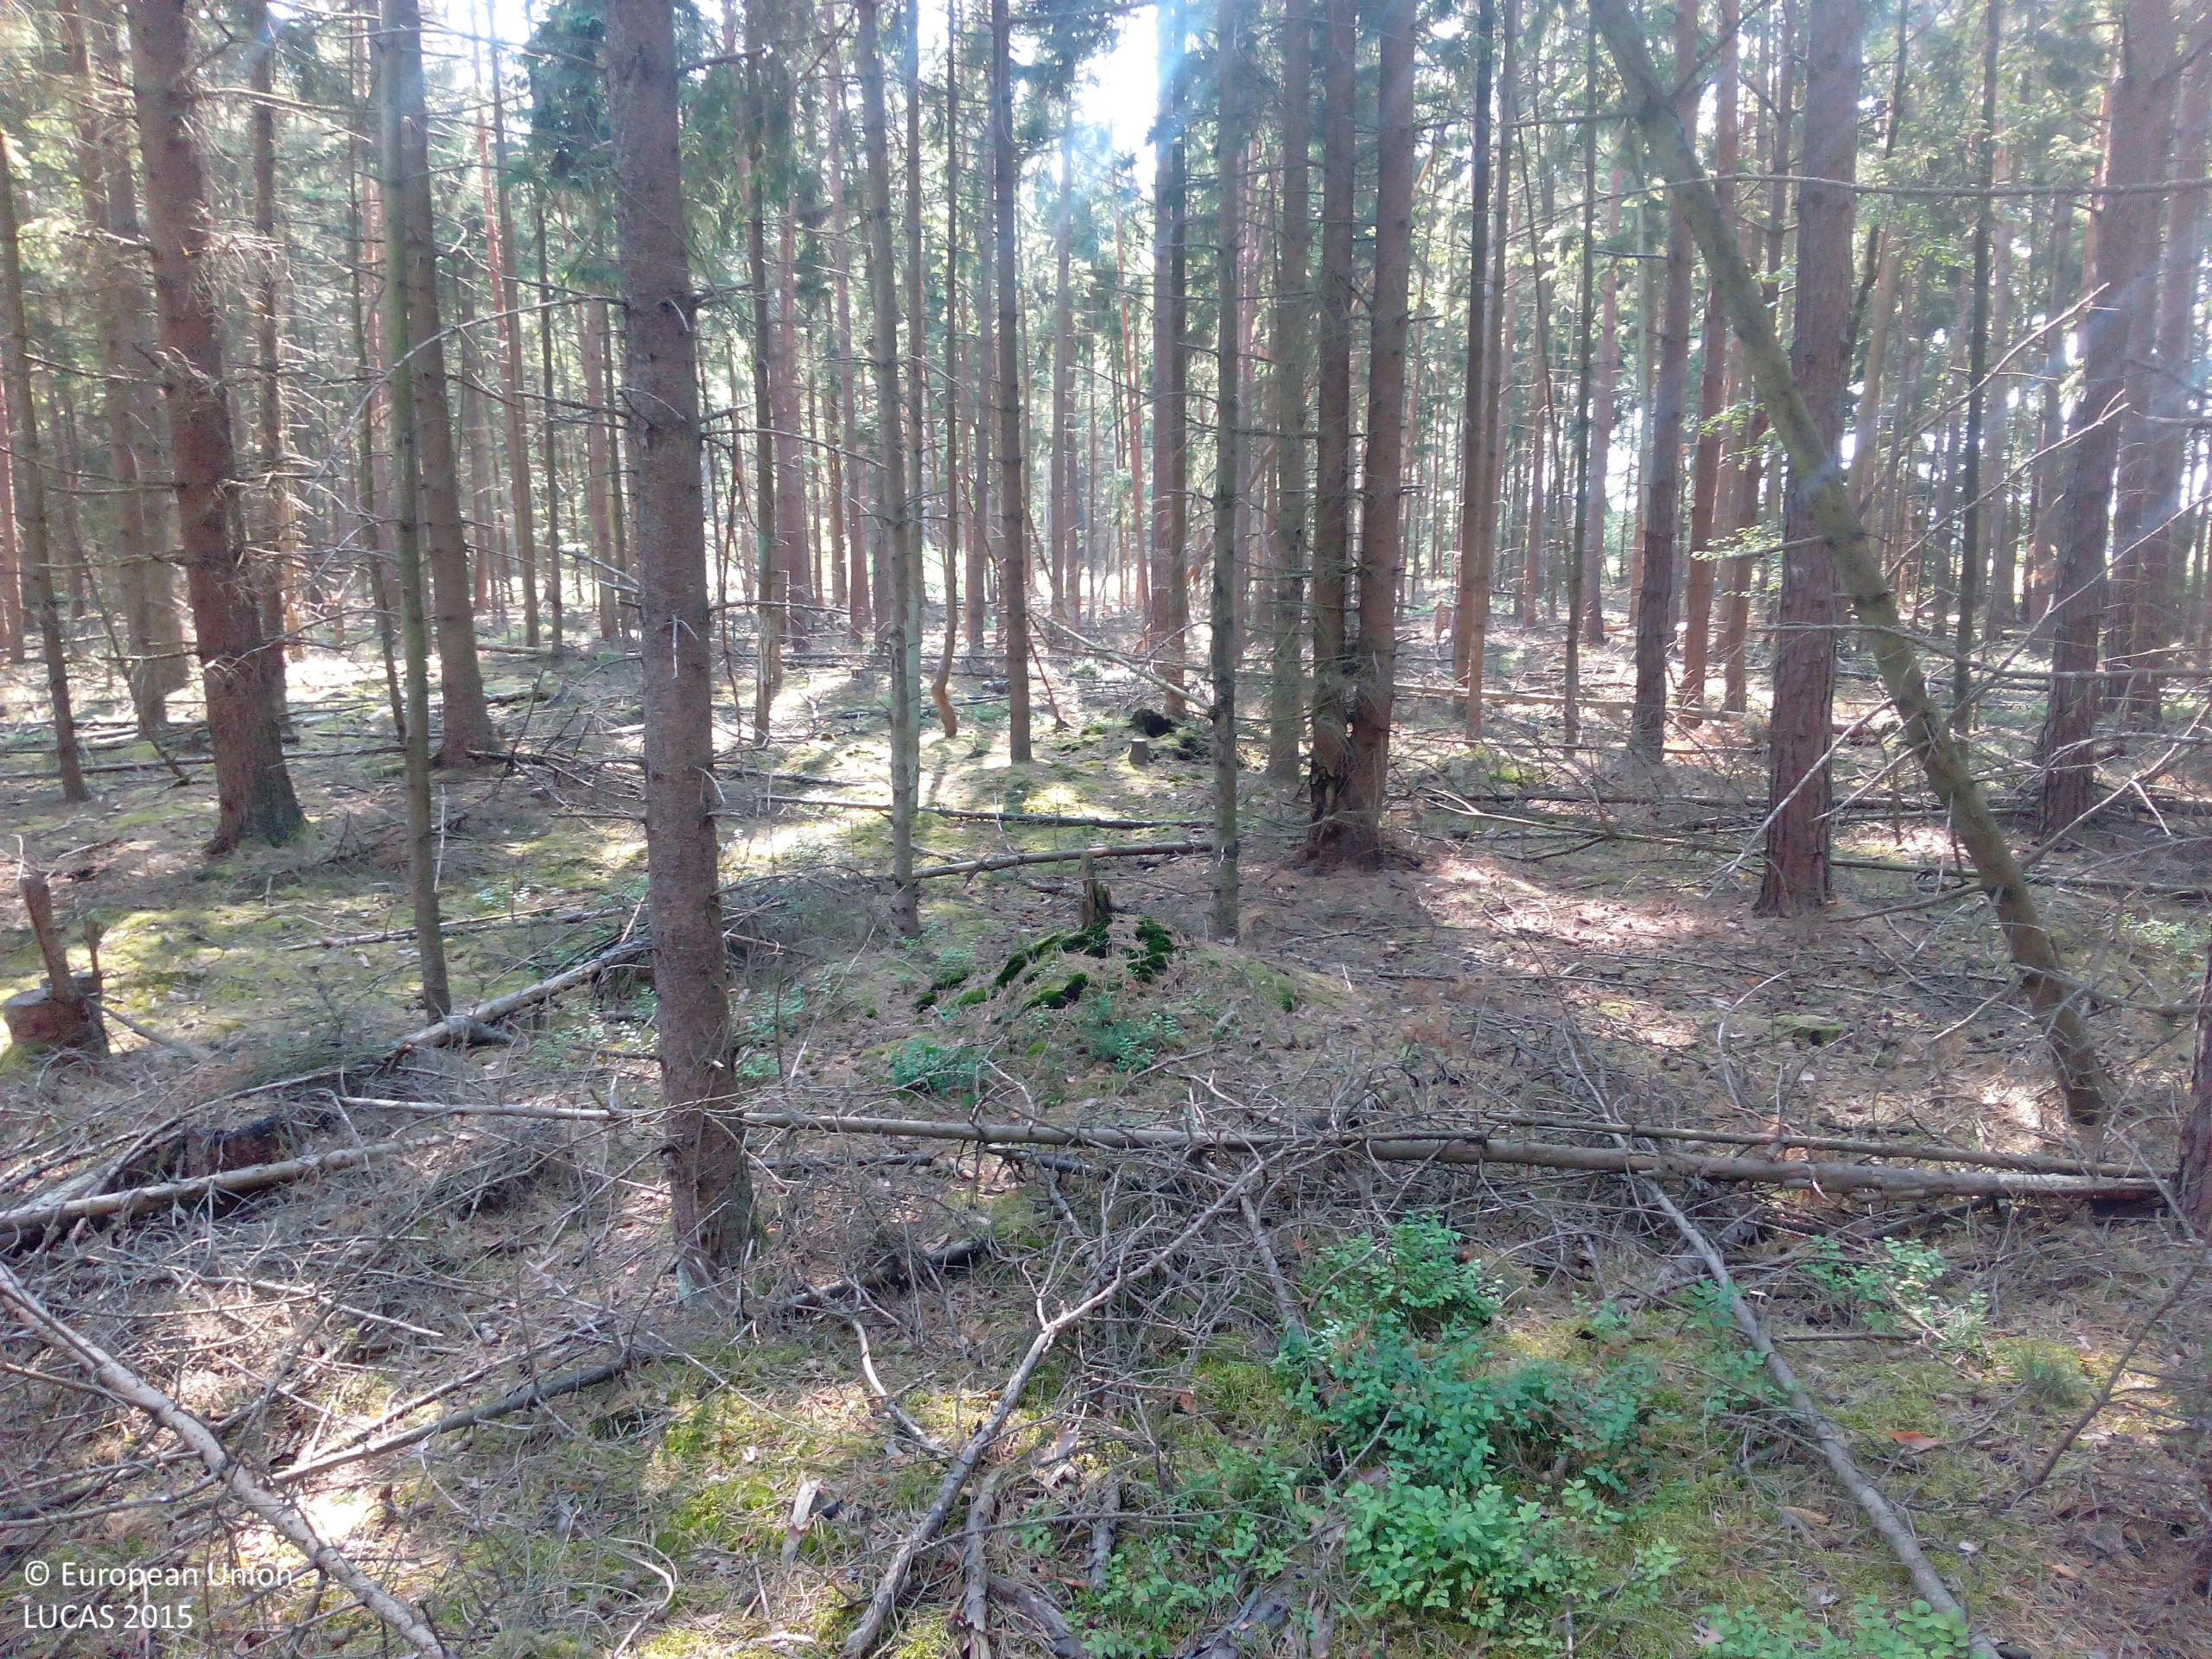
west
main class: Woodland
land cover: Spruce dominated coniferous woodland
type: hemiboreal forest and nemoral coniferous forest and mixed broadleaved-coniferous forest
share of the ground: > 75 %
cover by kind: coniferous forest trees 80 %, shrubs 10 %, herbaceous plants 10 %
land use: Forestry
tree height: > 5 m
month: July
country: DE
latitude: 52.6813
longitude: 10.6358
